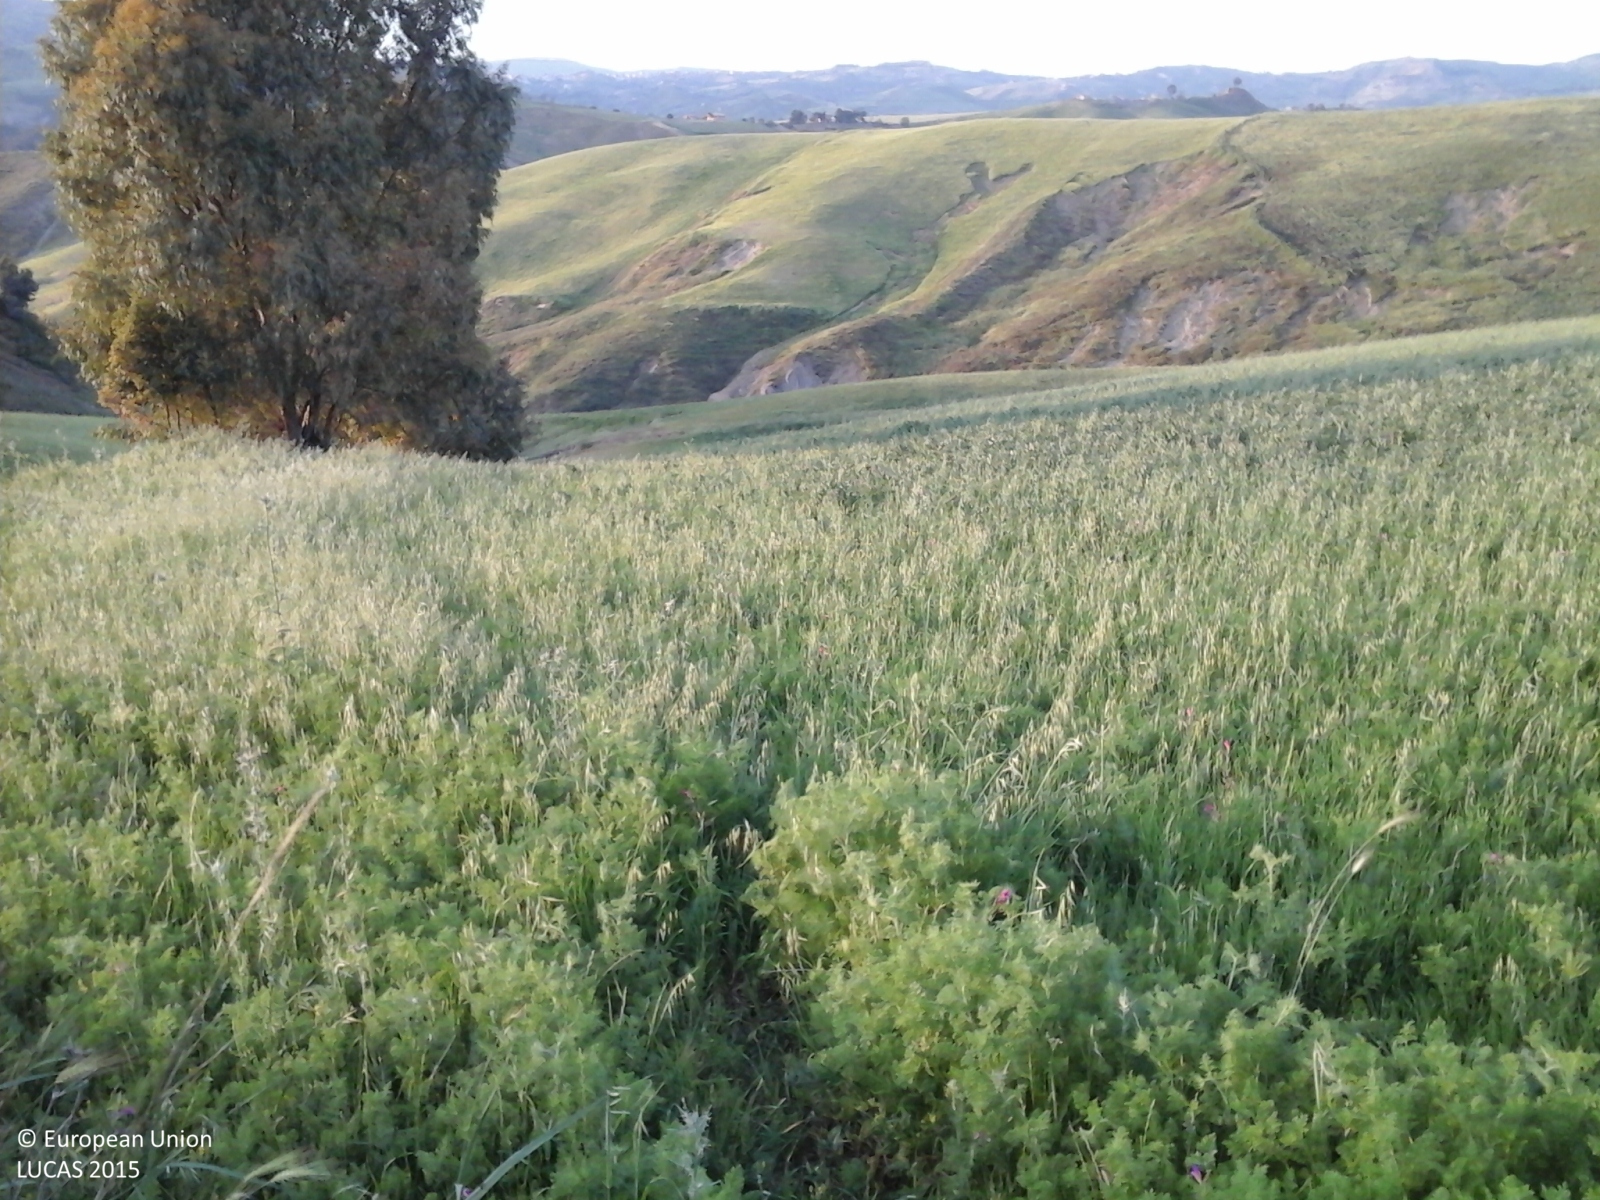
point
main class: Cropland
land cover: Other leguminous and mixtures for fodder
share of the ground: > 75 %
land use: Agriculture (excluding fallow land and kitchen gardens)
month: May
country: IT
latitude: 37.5348
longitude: 14.0327
